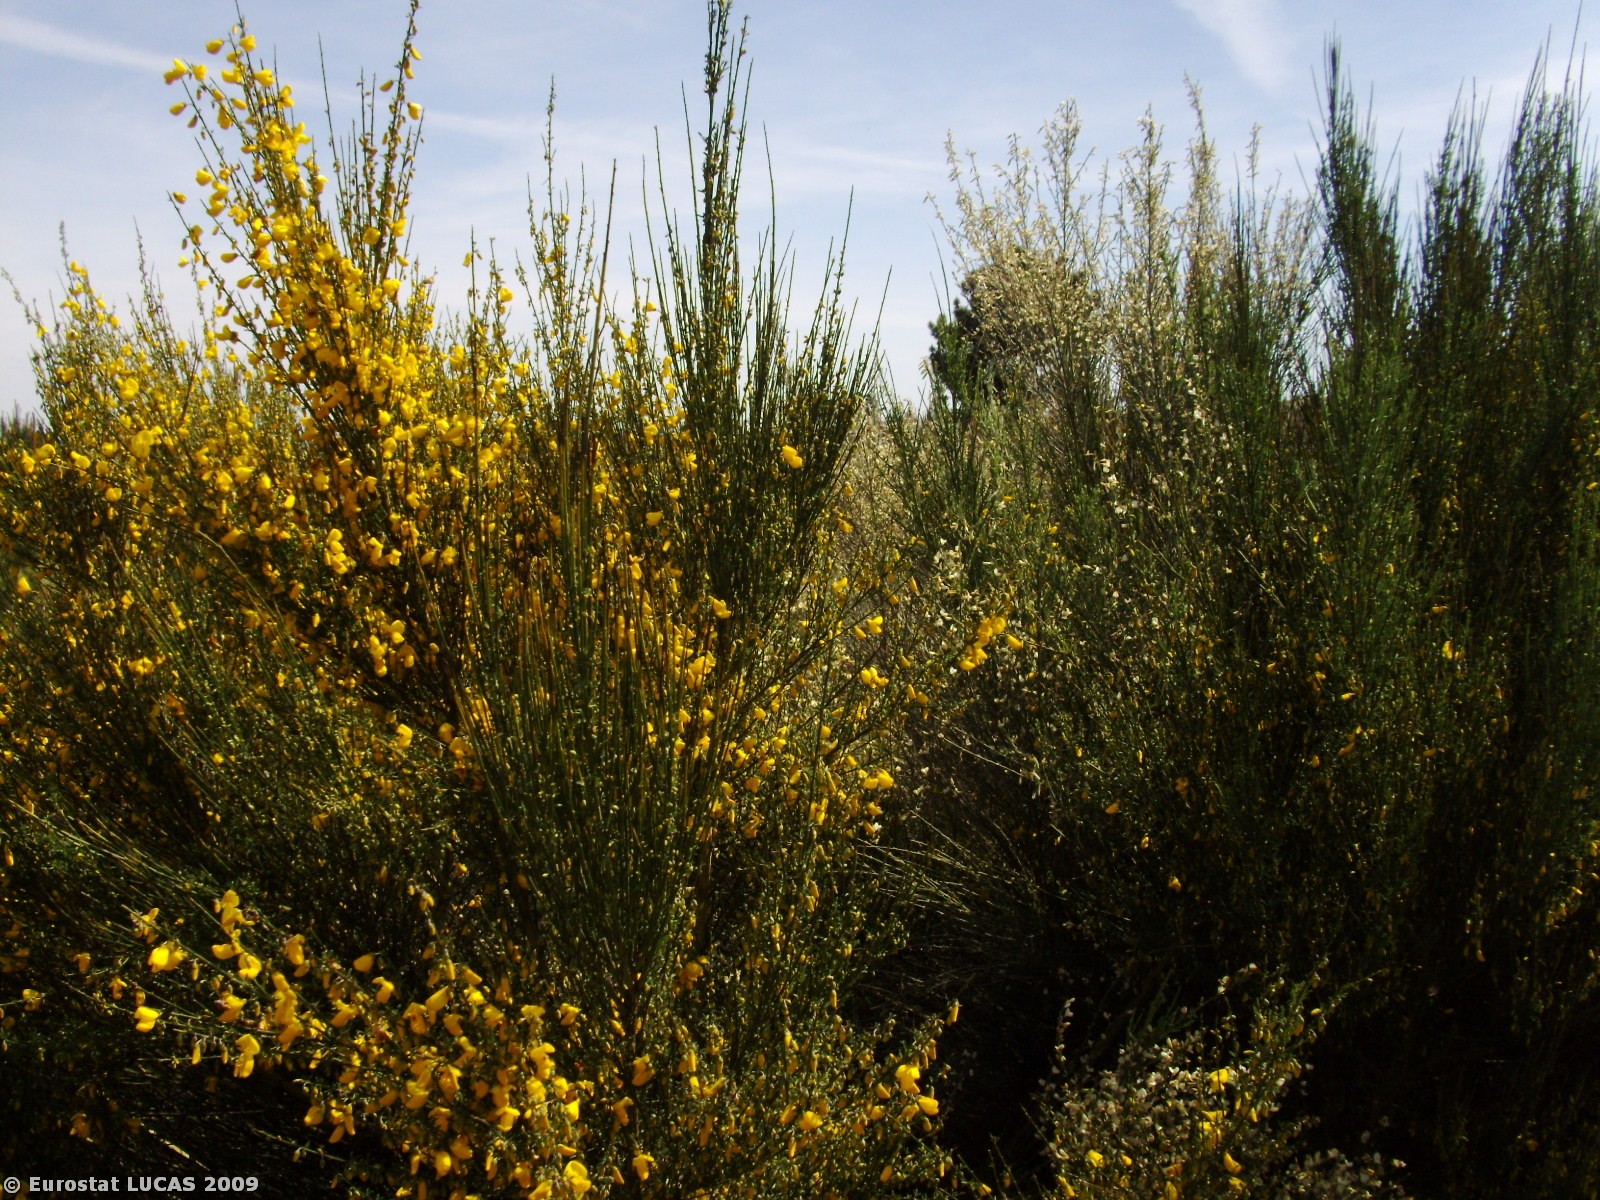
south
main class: Woodland
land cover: Coniferous woodland
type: coniferous forest of the mediterranean region
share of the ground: > 75 %
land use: Forestry
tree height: > 5 m
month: May
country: PT
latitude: 40.9405
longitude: -7.3492
